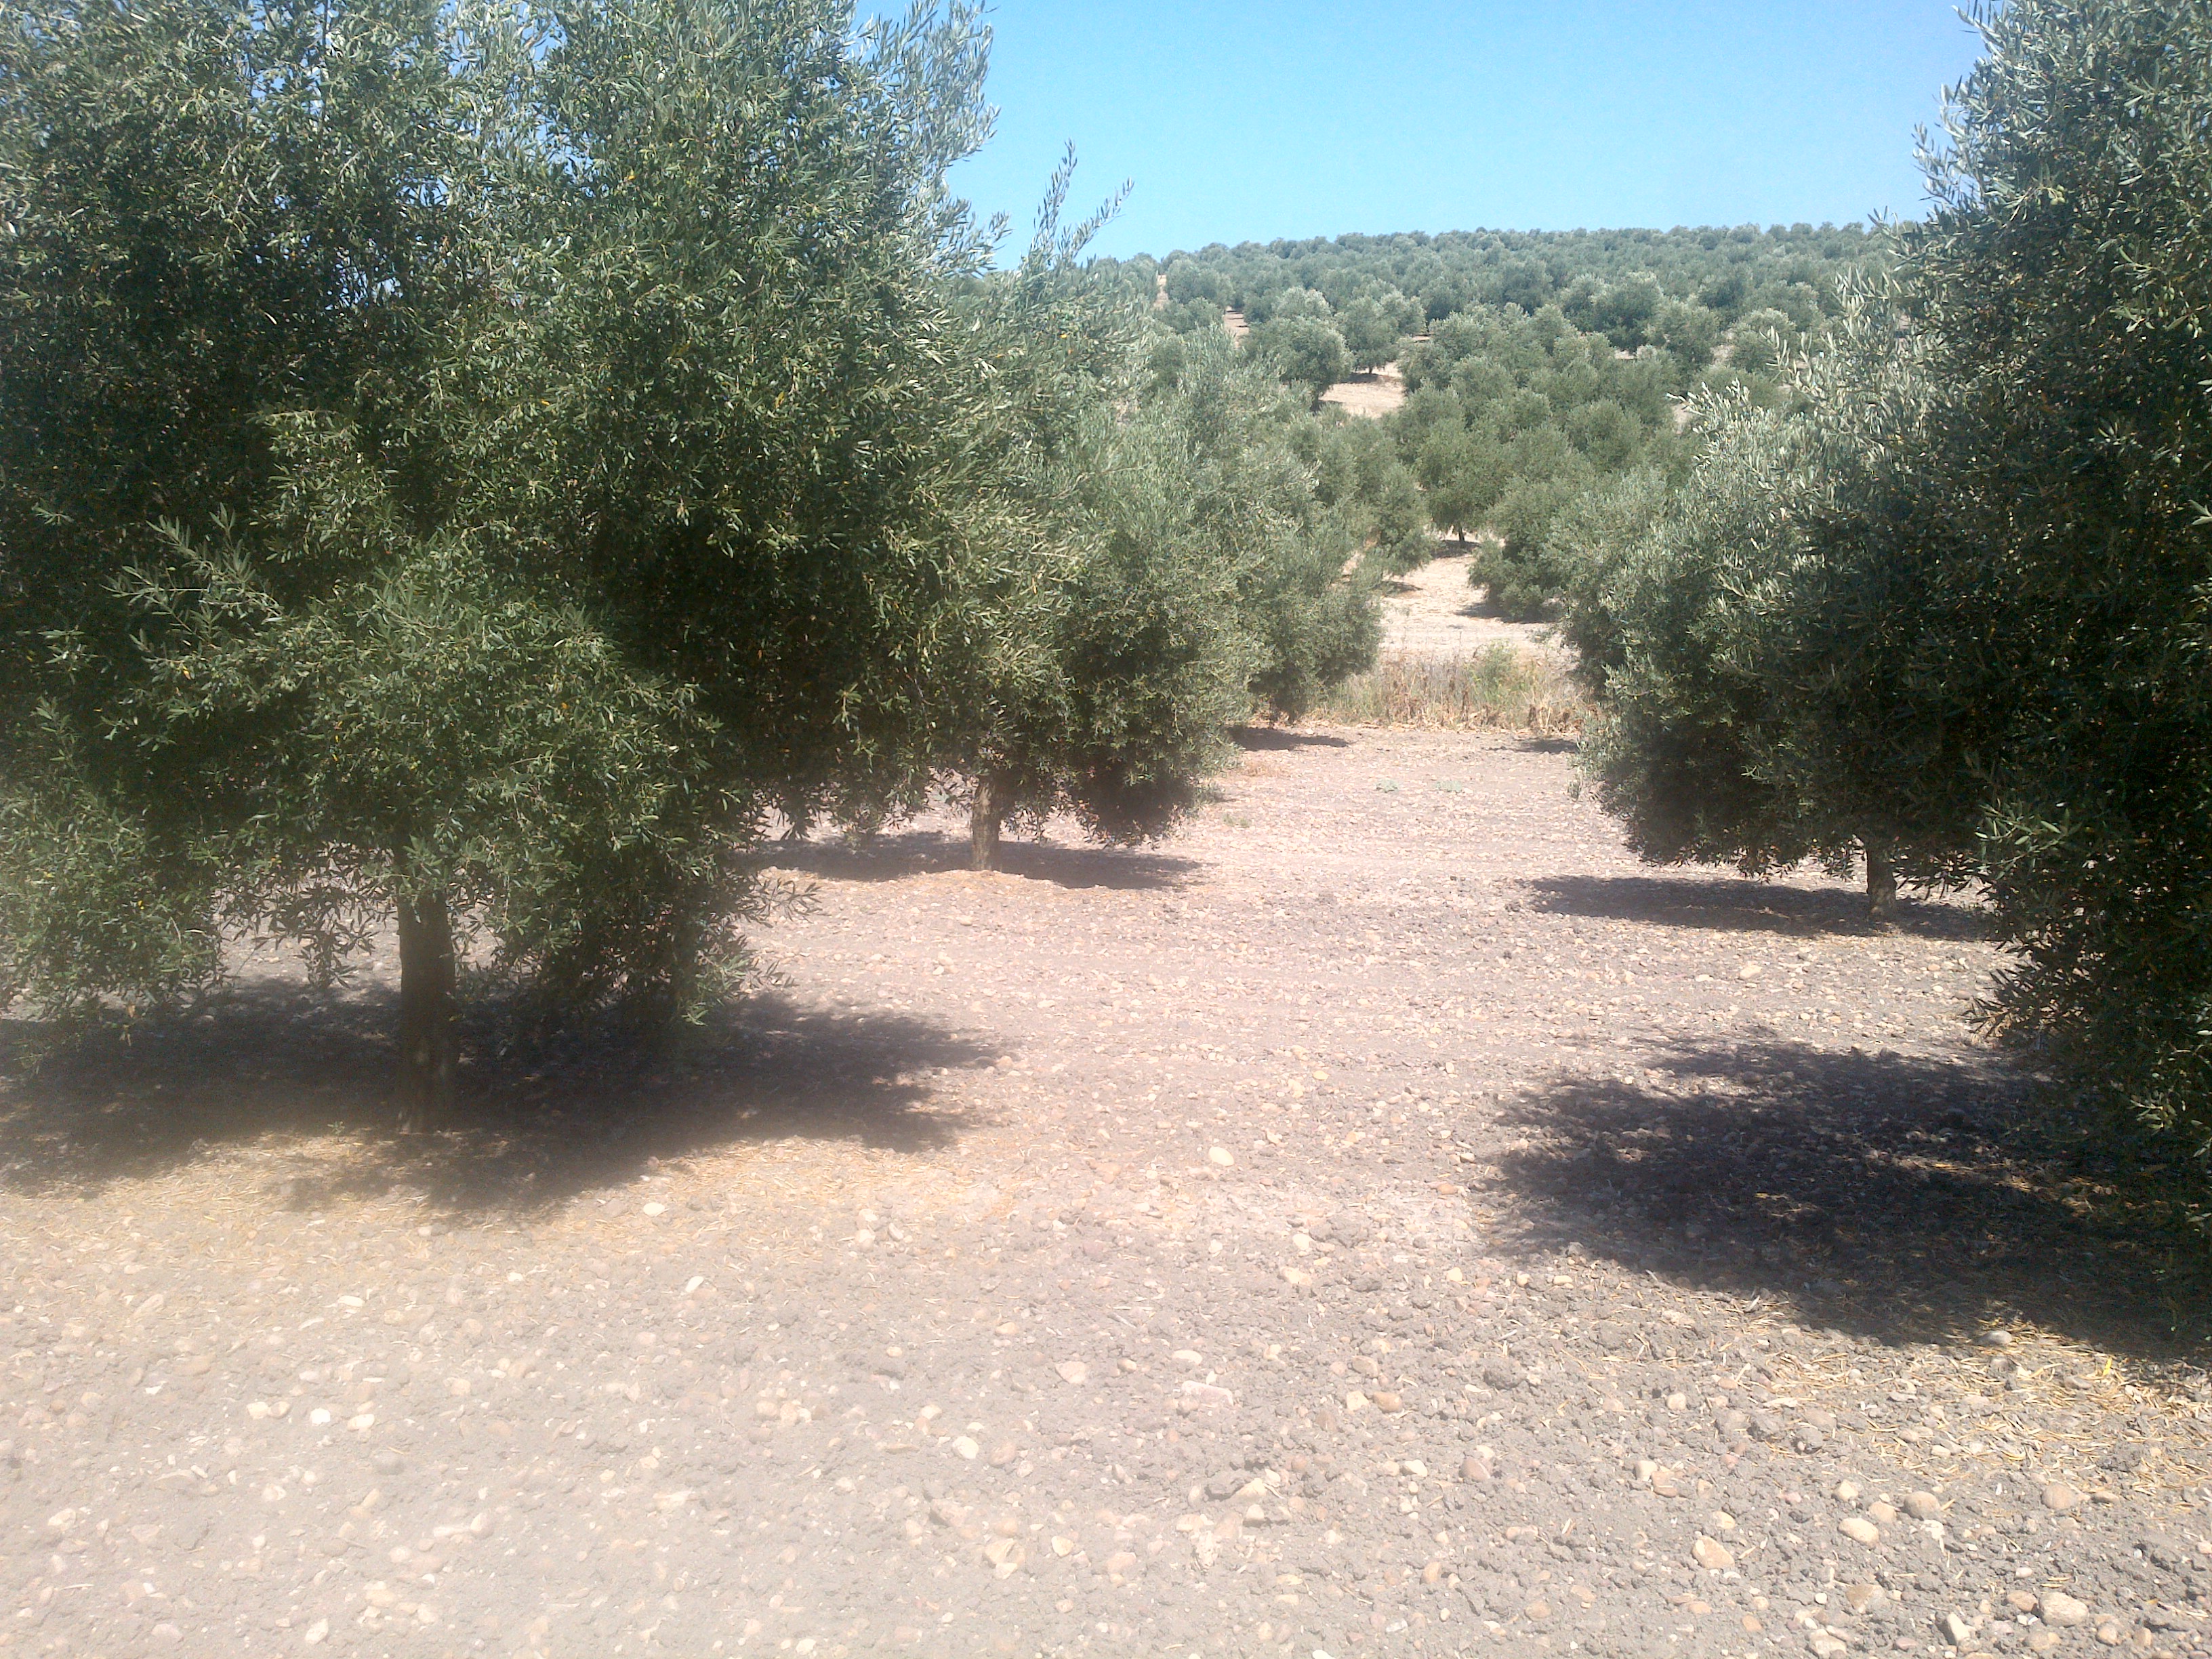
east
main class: Cropland
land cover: Olive groves
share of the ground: 50 - 75 %
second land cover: Other bare soil
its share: > 75 %
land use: Agriculture (excluding fallow land and kitchen gardens)
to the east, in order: Olive groves; Other bare soil; Grass margins; Rivers and streams; Grass margins; Olive groves
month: June
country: ES
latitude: 37.5997
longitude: -4.8828
